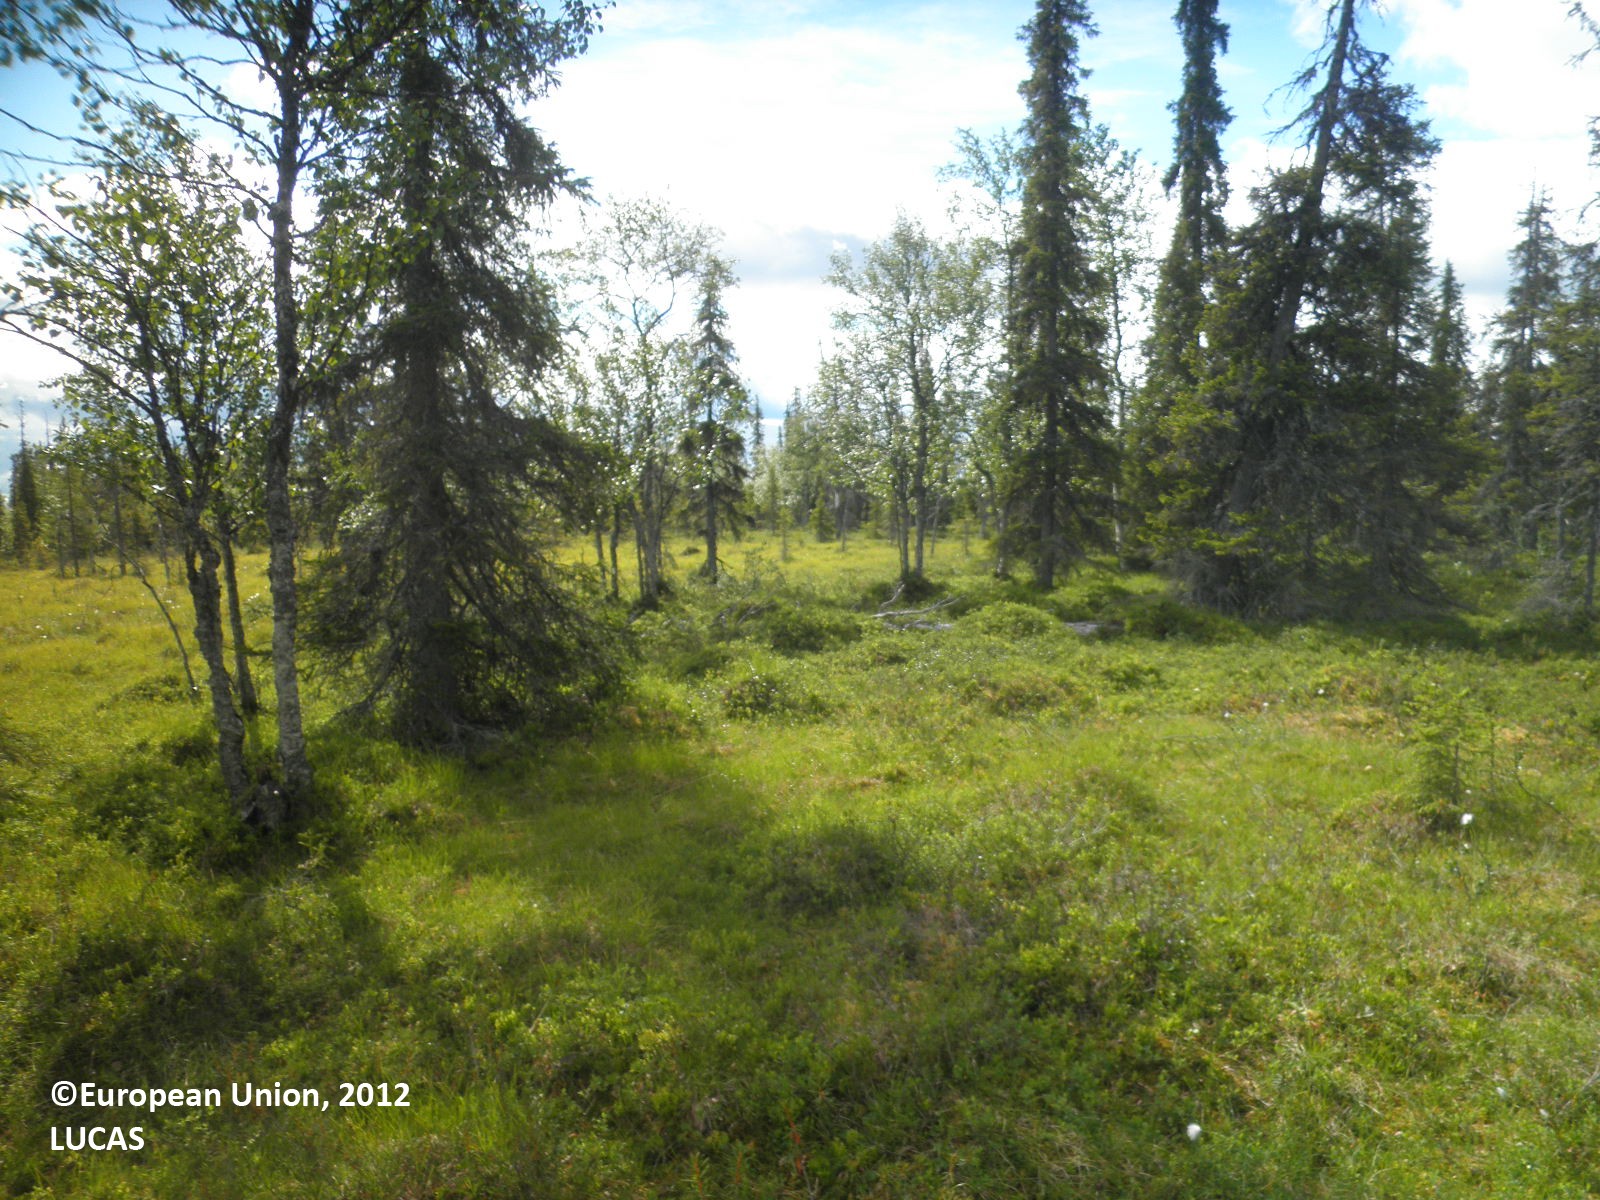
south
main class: Woodland
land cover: Spruce dominated mixed woodland
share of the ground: 10 - 25 %
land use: Forestry
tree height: > 5 m
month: July
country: FI
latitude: 67.8351
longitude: 26.3319
